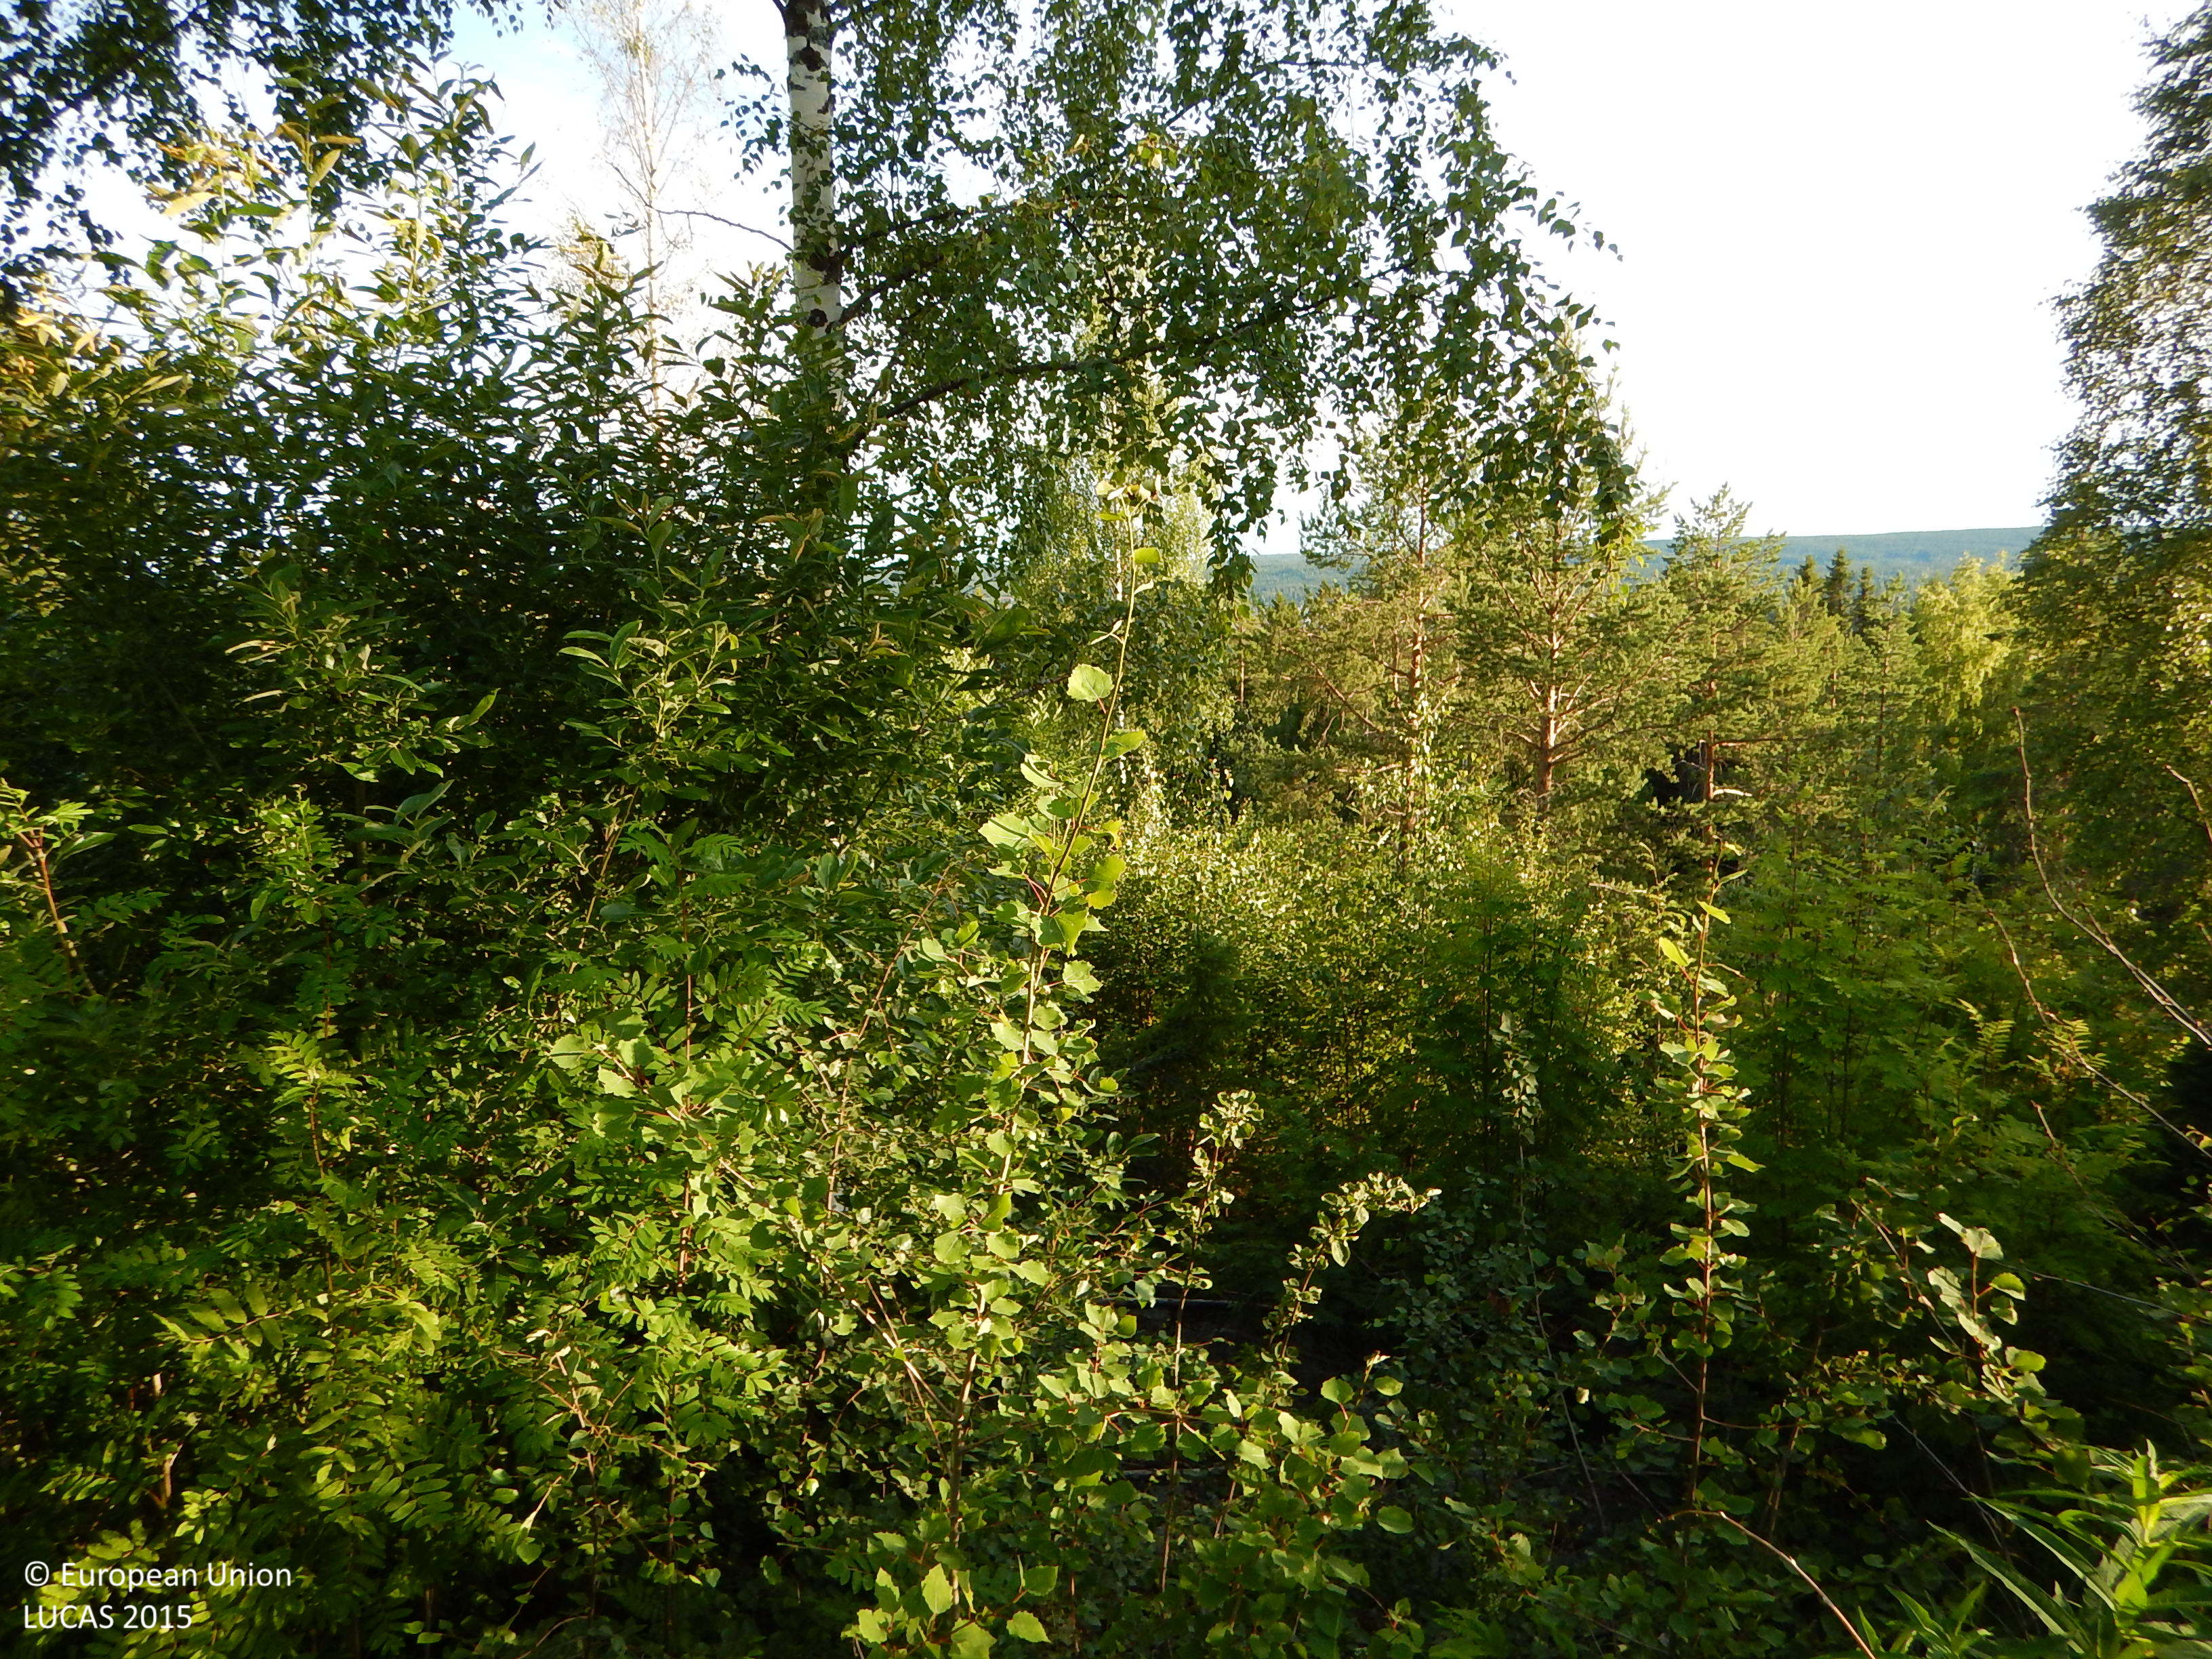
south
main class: Woodland
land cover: Broadleaved woodland
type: boreal forest
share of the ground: 50 - 75 %
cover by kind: broadleaved forest trees 50 %, shrubs 20 %, herbaceous plants 20 %, coniferous forest trees 10 %
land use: Semi-natural and natural areas not in use
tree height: > 5 m
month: July
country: SE
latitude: 64.7659
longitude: 20.9729
